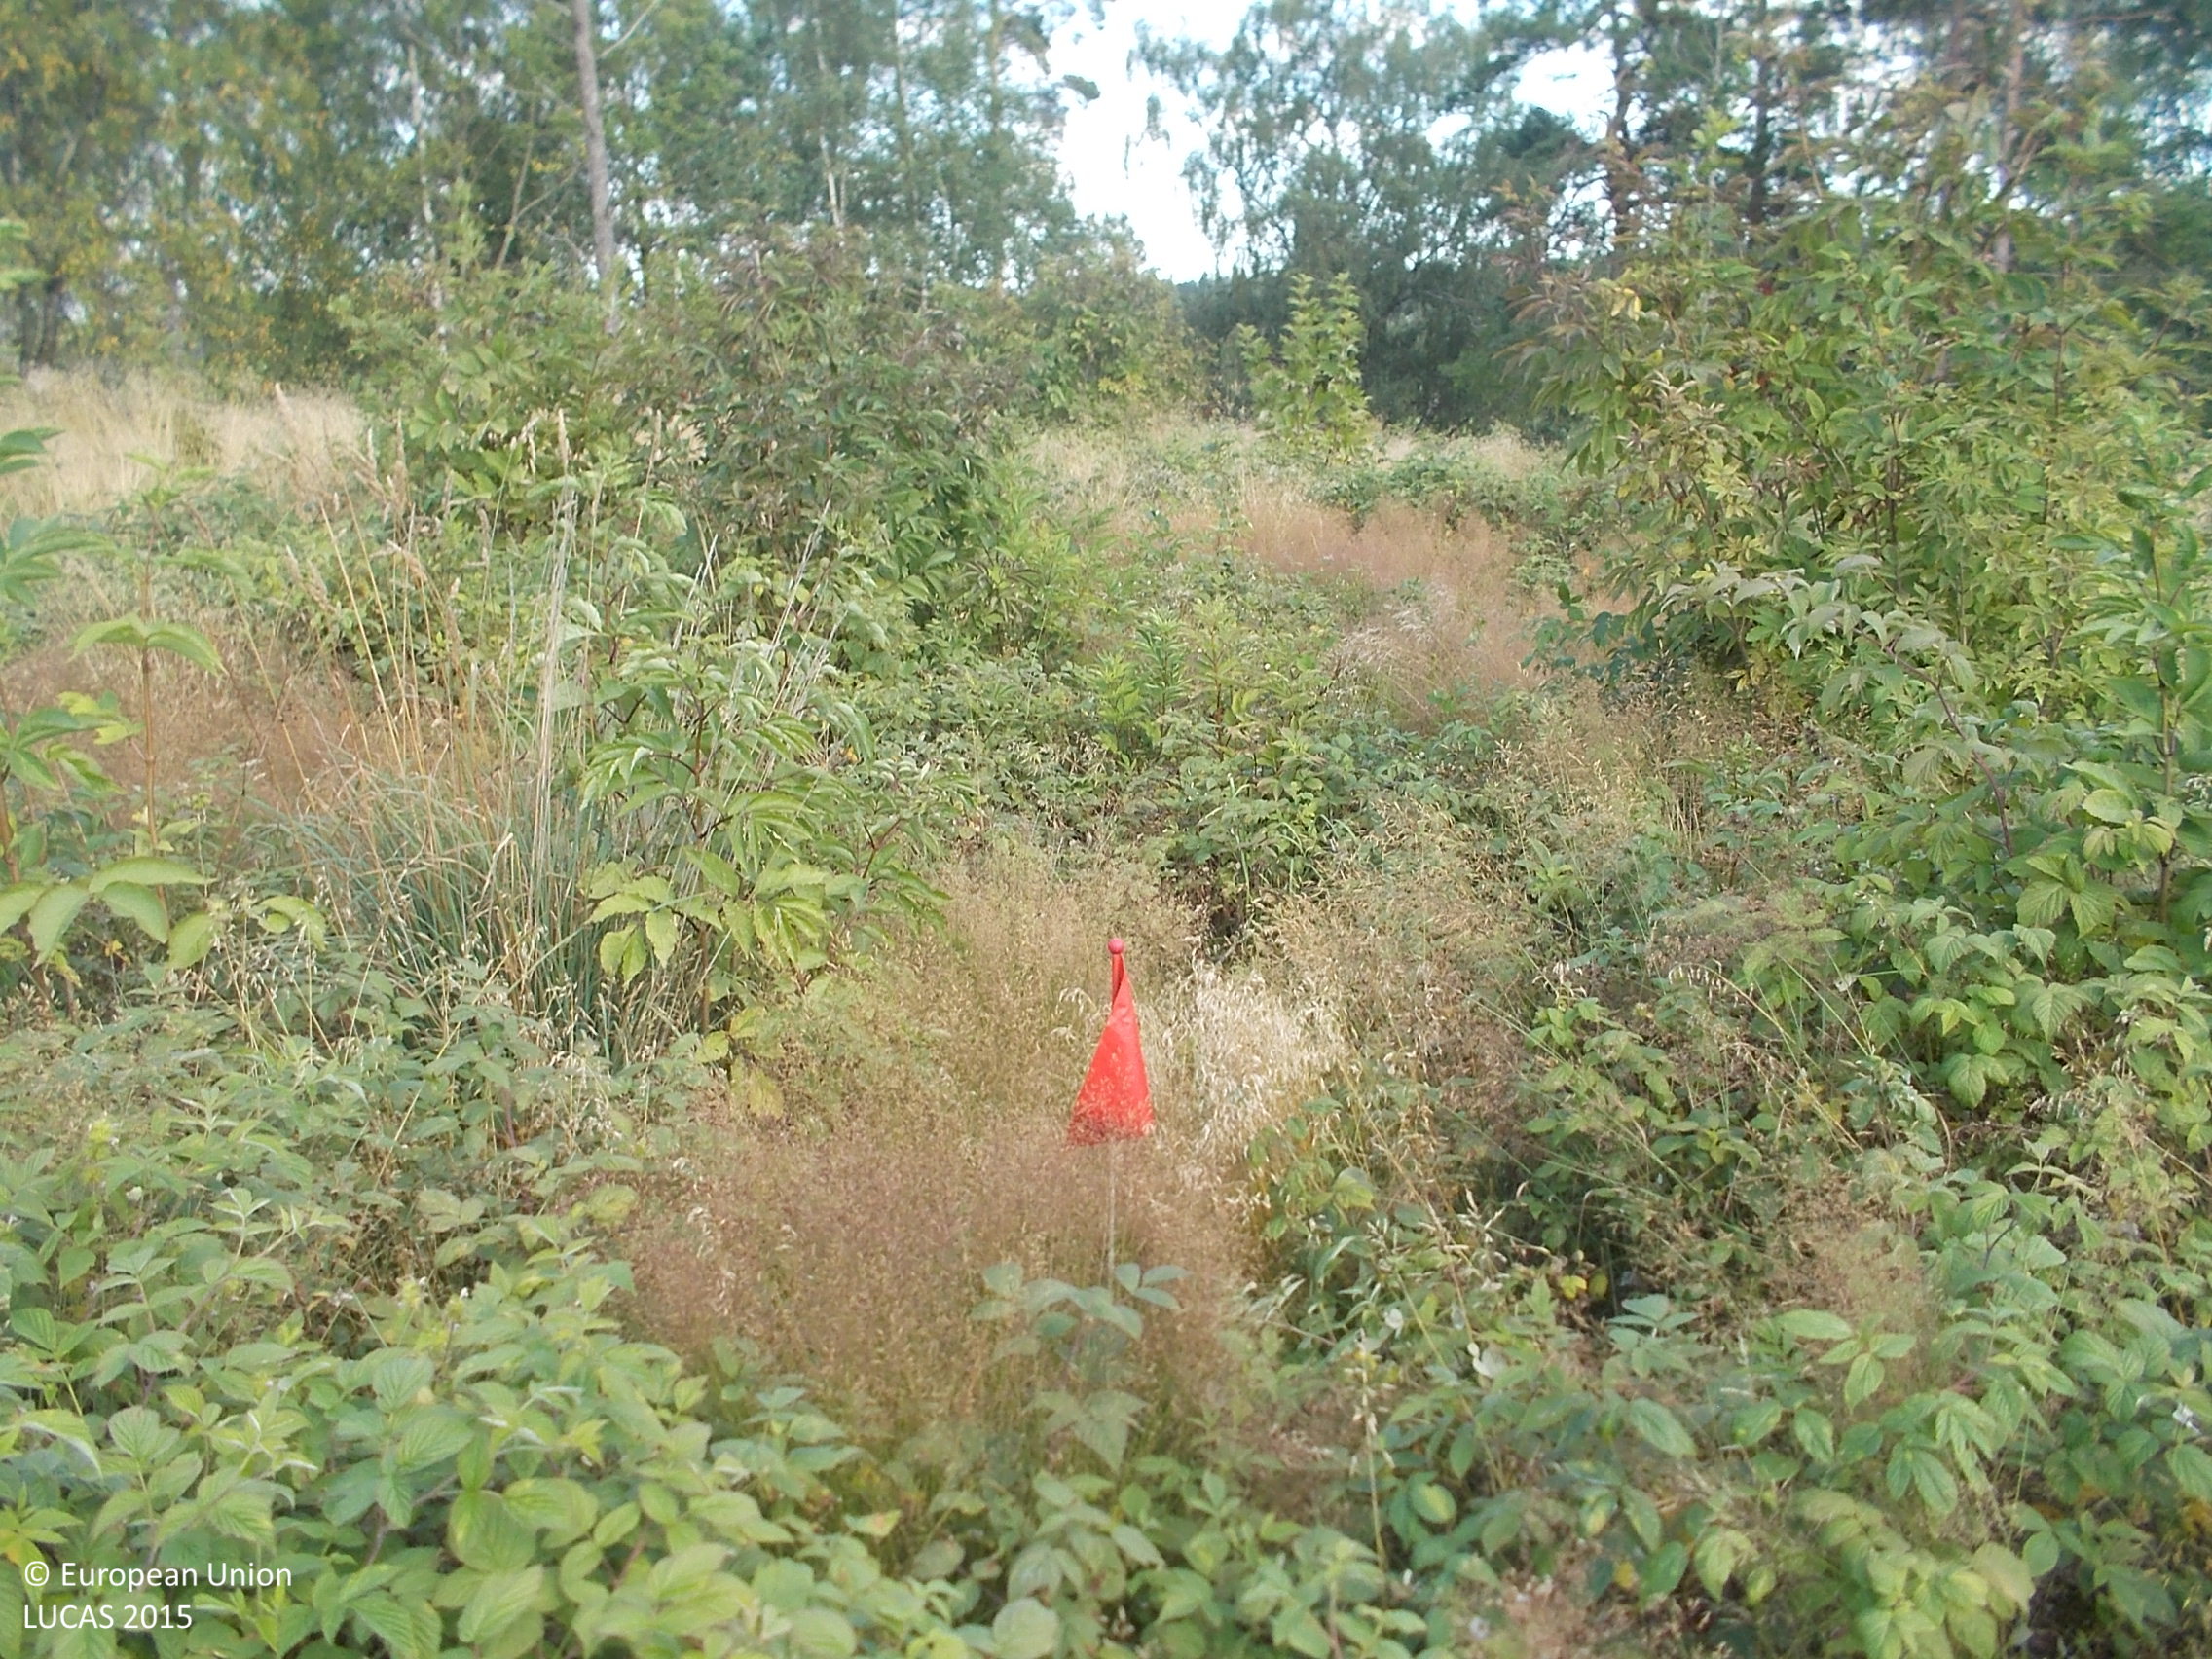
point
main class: Shrubland
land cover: Shrubland with sparse tree cover
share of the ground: > 75 %
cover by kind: shrubs 80 %, herbaceous plants 15 %, broadleaved forest trees 5 %
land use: Forestry
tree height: > 5 m
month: August
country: SE
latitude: 57.5510
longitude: 13.2207
